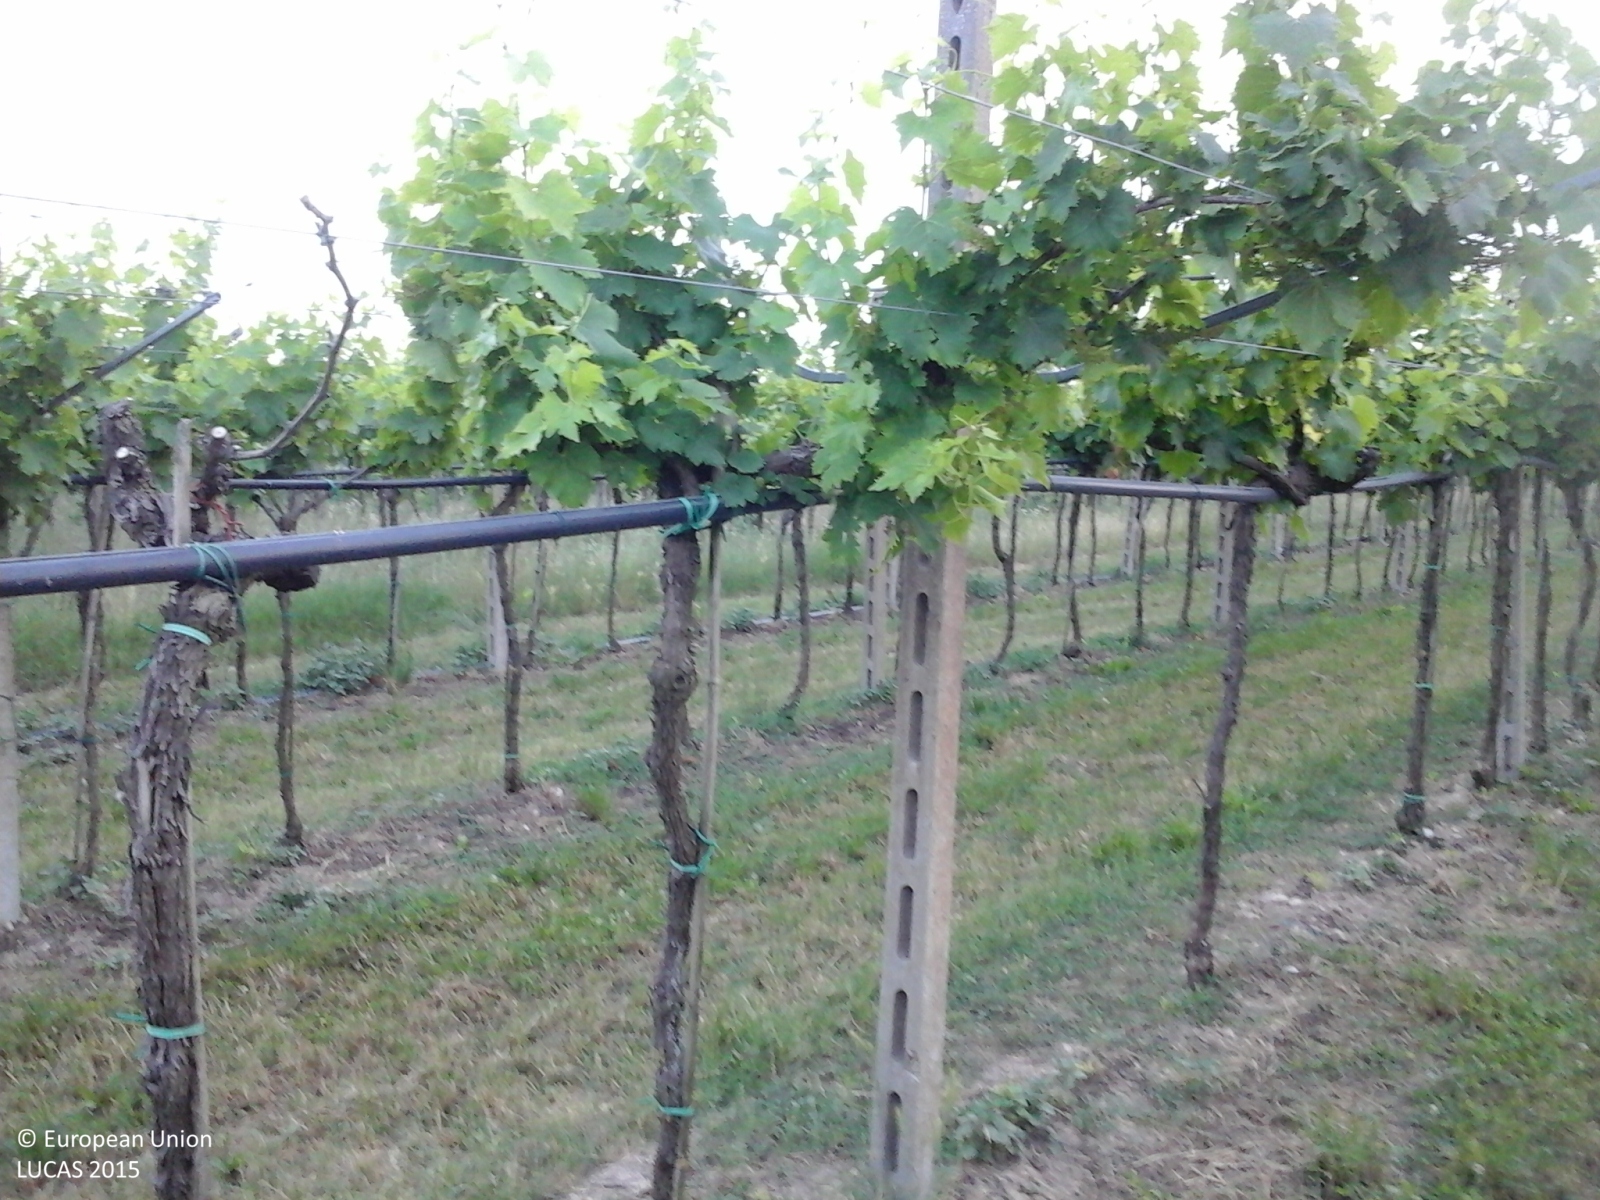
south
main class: Cropland
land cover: Vineyards
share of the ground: 50 - 75 %
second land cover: Grassland without tree/shrub cover
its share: > 75 %
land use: Agriculture (excluding fallow land and kitchen gardens)
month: June
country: IT
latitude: 45.5914
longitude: 10.8062
